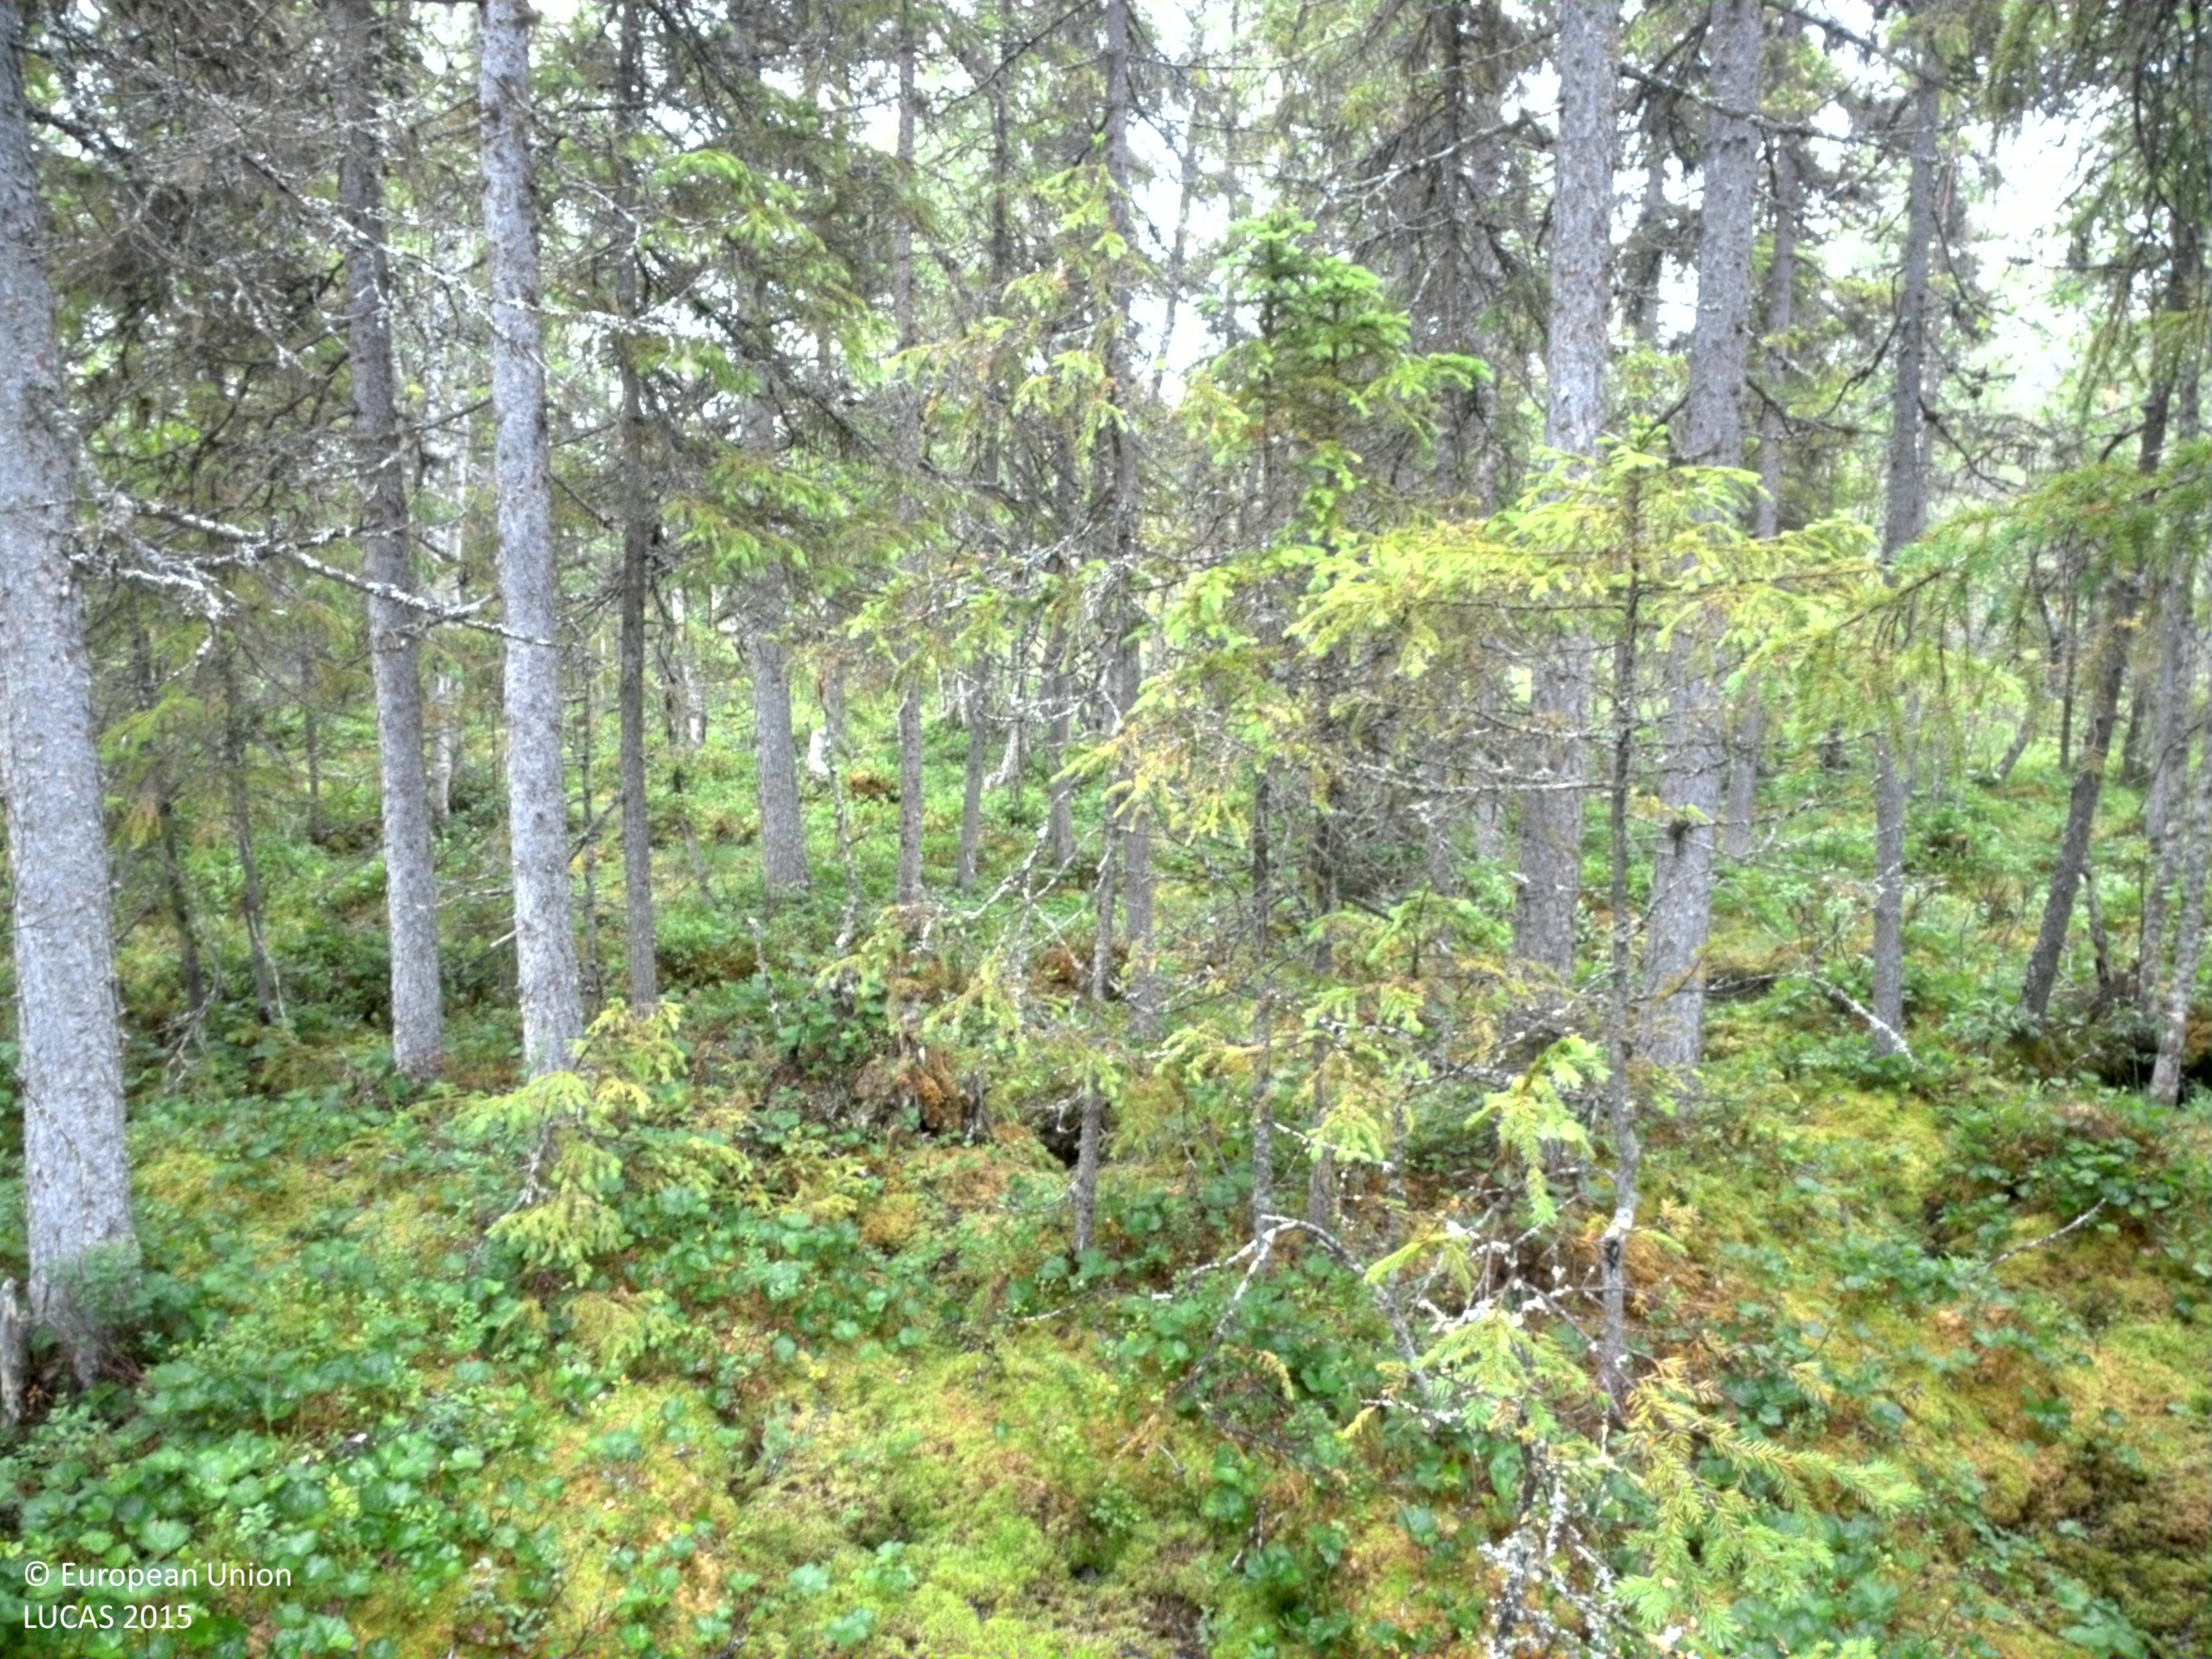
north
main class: Woodland
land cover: Spruce dominated mixed woodland
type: mire and swamp forests
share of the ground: 50 - 75 %
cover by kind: coniferous forest trees 45 %, lichens and mosses 20 %, broadleaved forest trees 15 %, shrubs 10 %, herbaceous plants 10 %
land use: Forestry
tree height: > 5 m
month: July
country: SE
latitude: 64.5628
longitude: 18.2931
